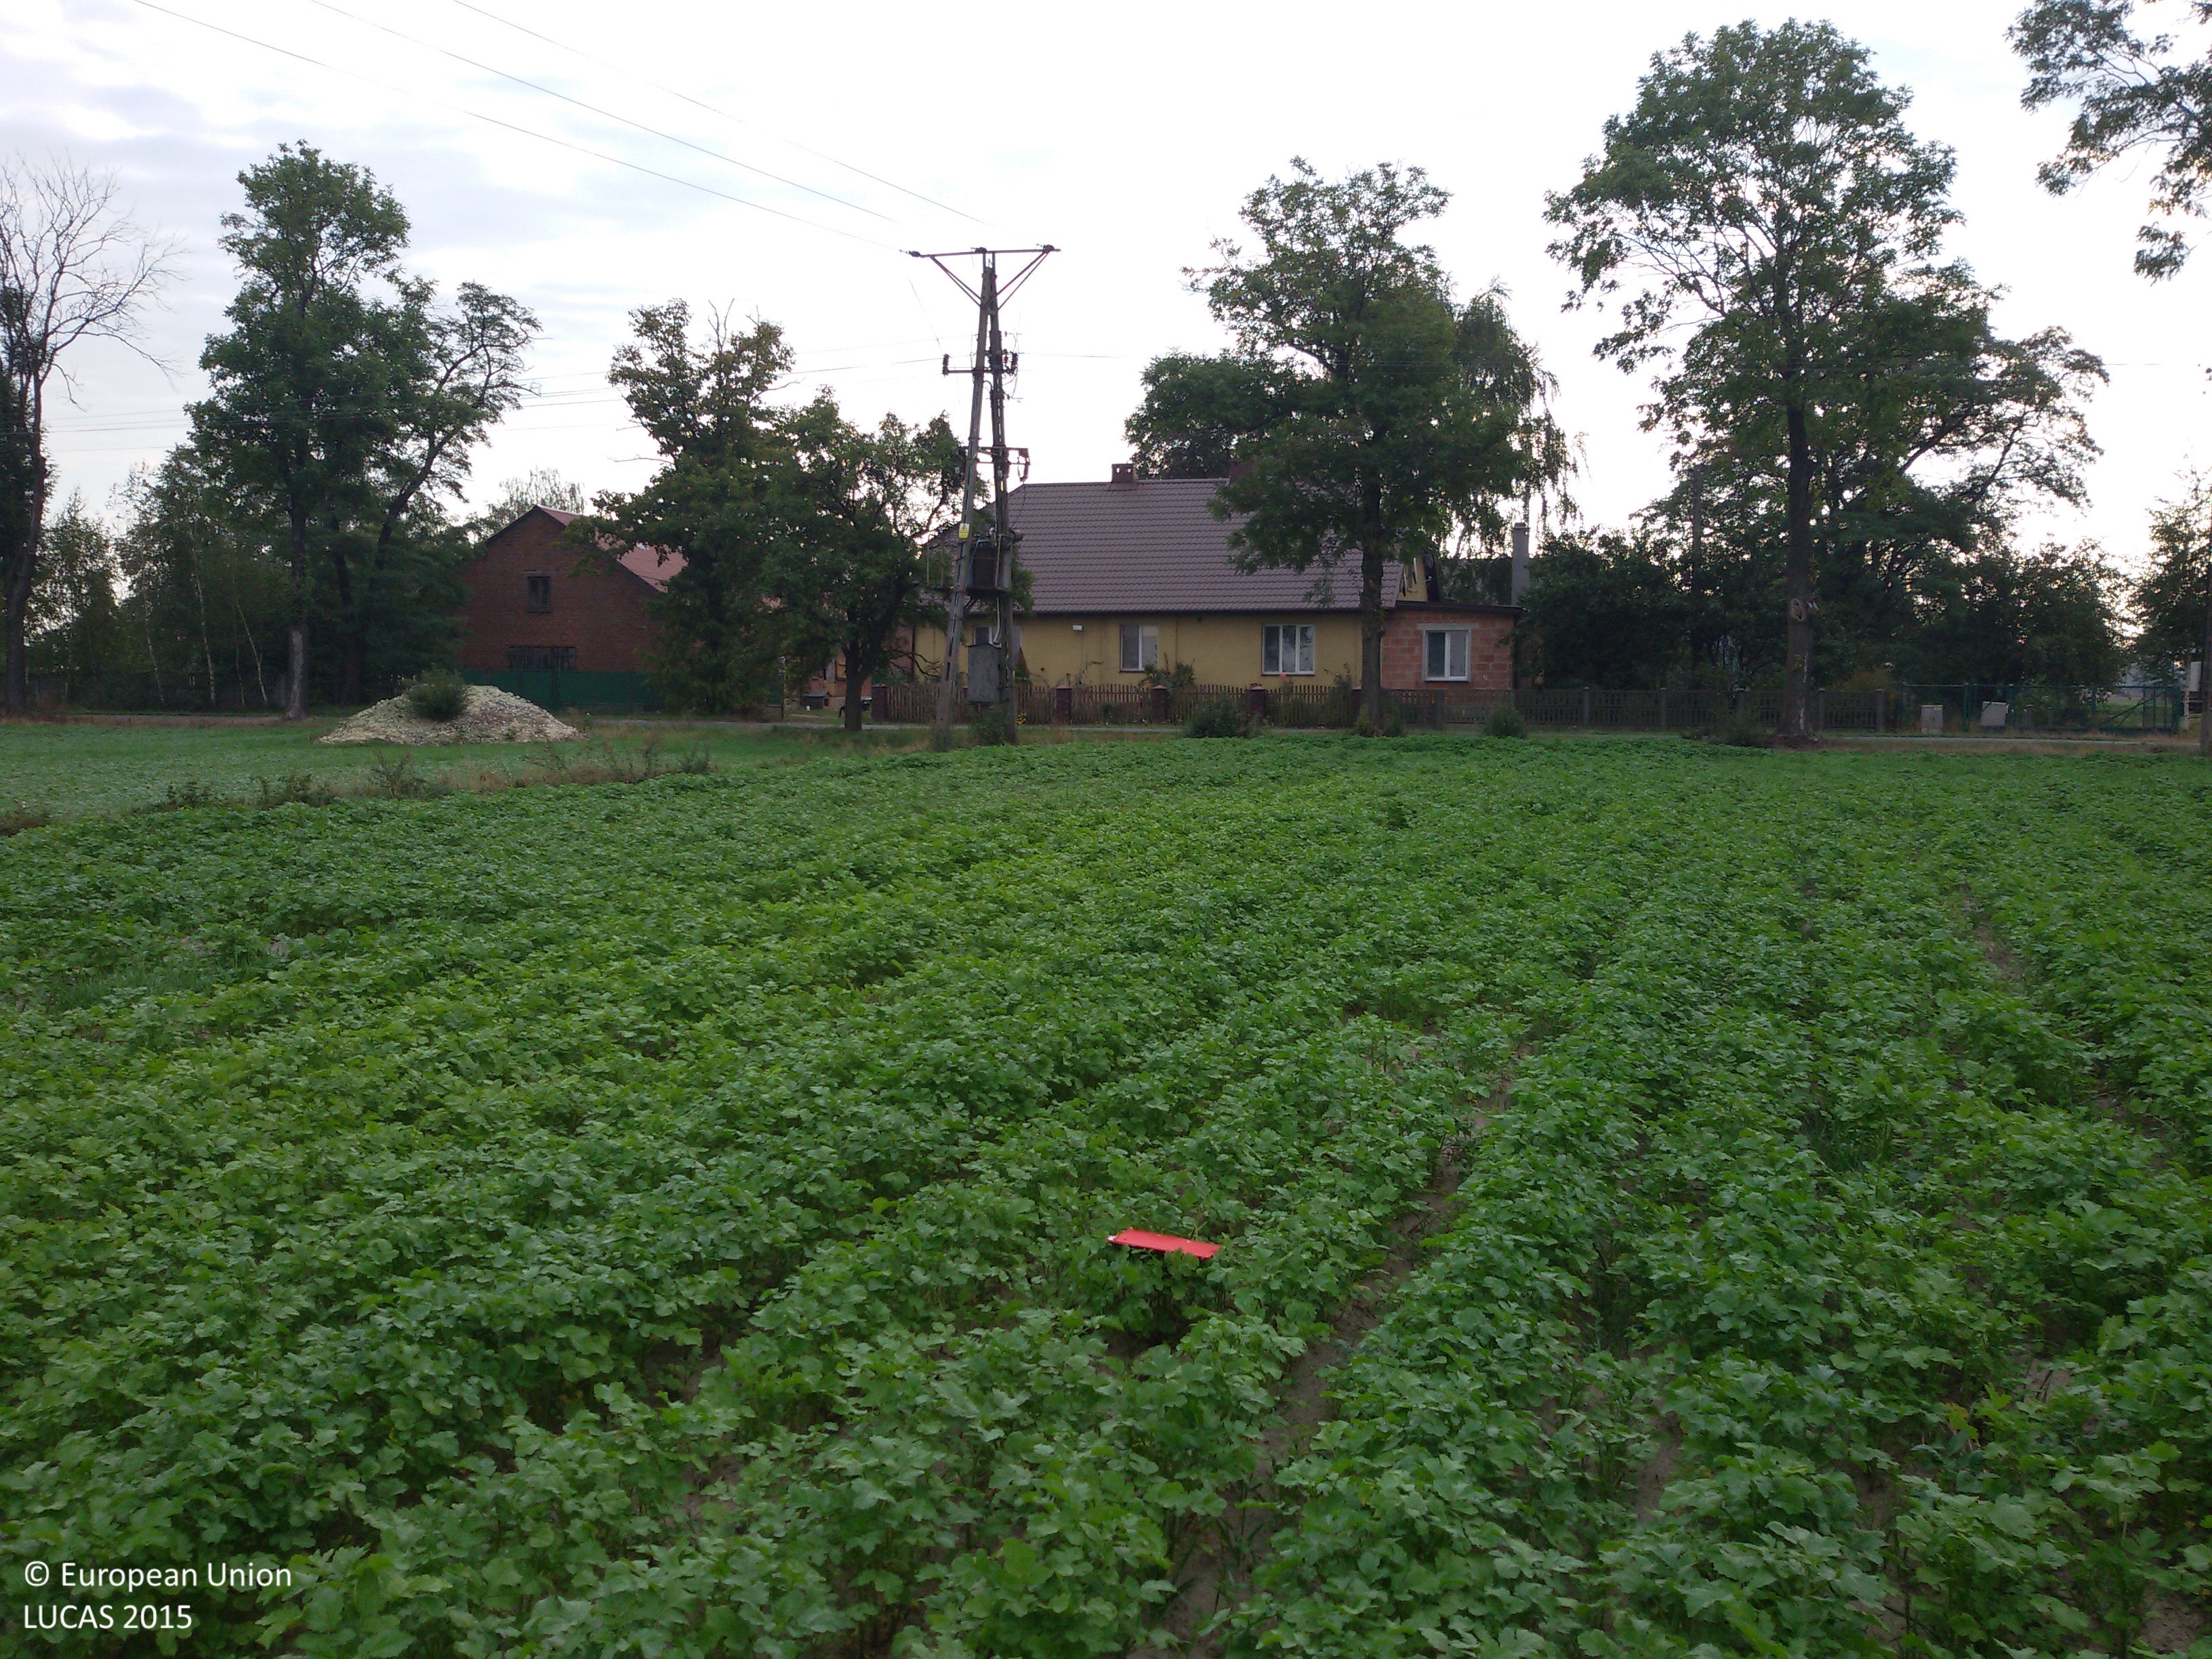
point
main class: Cropland
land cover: Rape and turnip rape
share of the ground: > 75 %
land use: Agriculture (excluding fallow land and kitchen gardens)
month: September
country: PL
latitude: 52.2895
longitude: 17.9763
